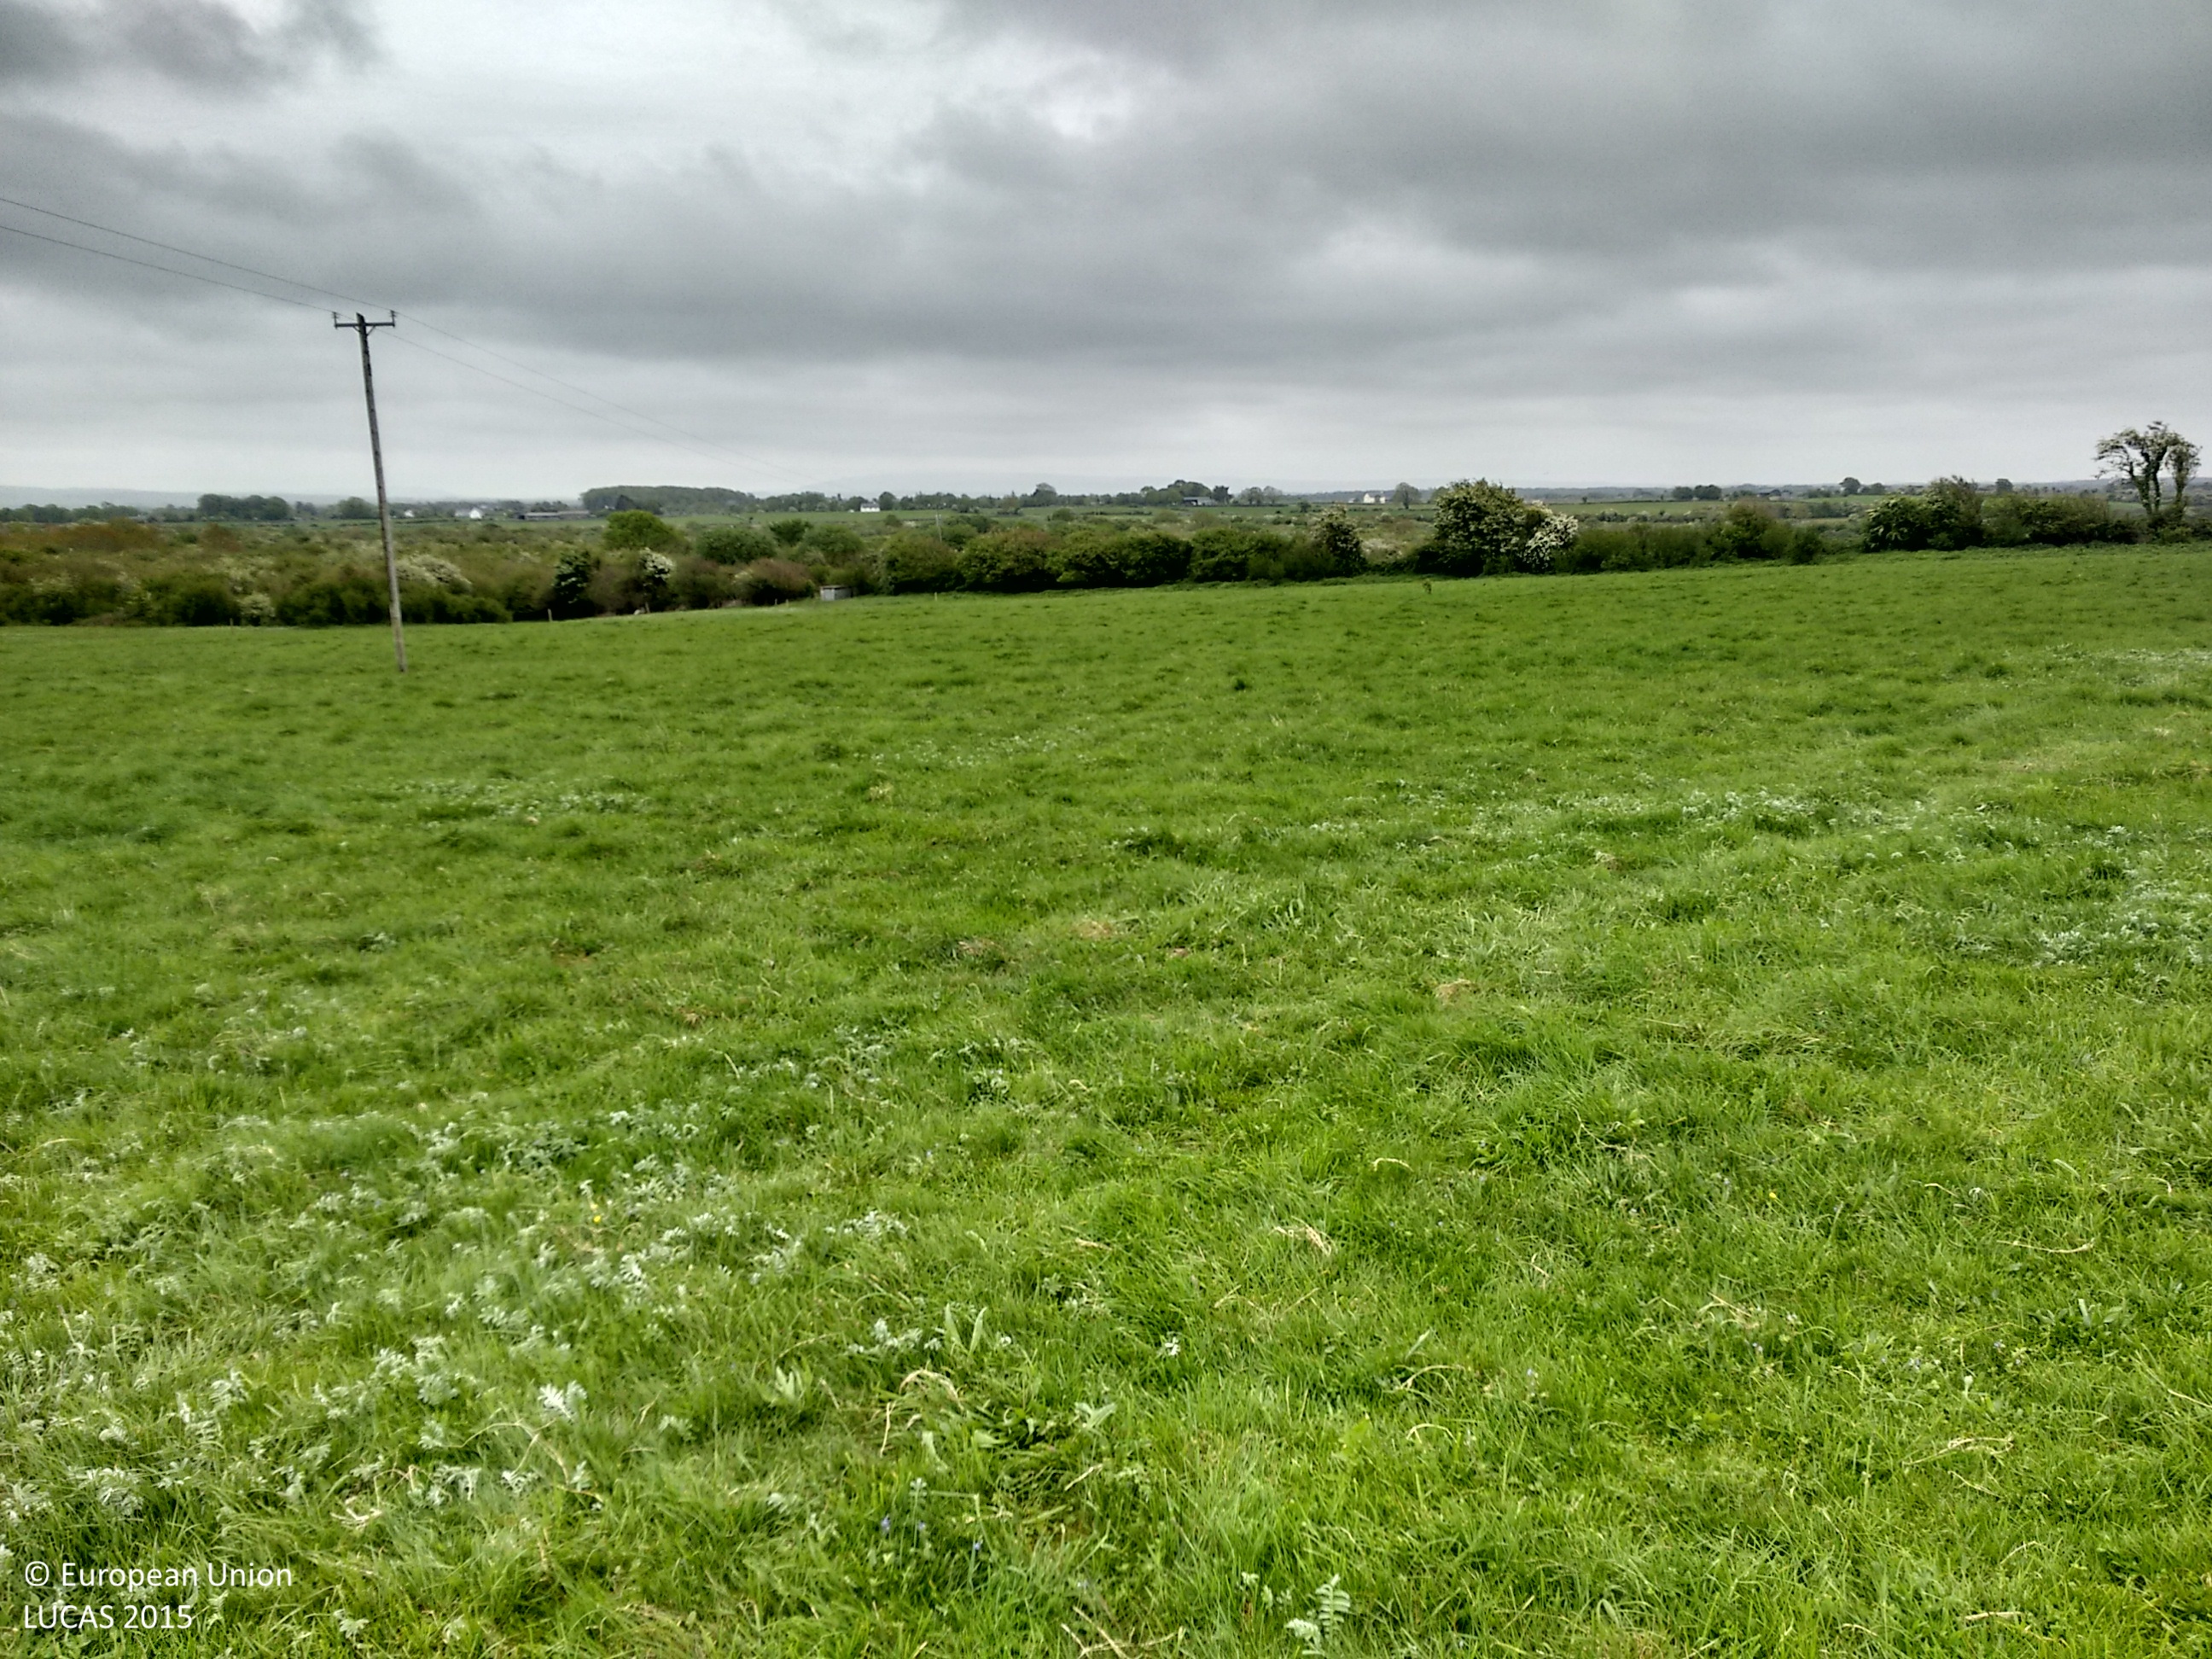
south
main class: Grassland
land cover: Grassland without tree/shrub cover
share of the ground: > 75 %
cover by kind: herbaceous plants 100 %
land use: Agriculture (excluding fallow land and kitchen gardens)
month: May
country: IE
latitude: 53.1407
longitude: -8.8486
